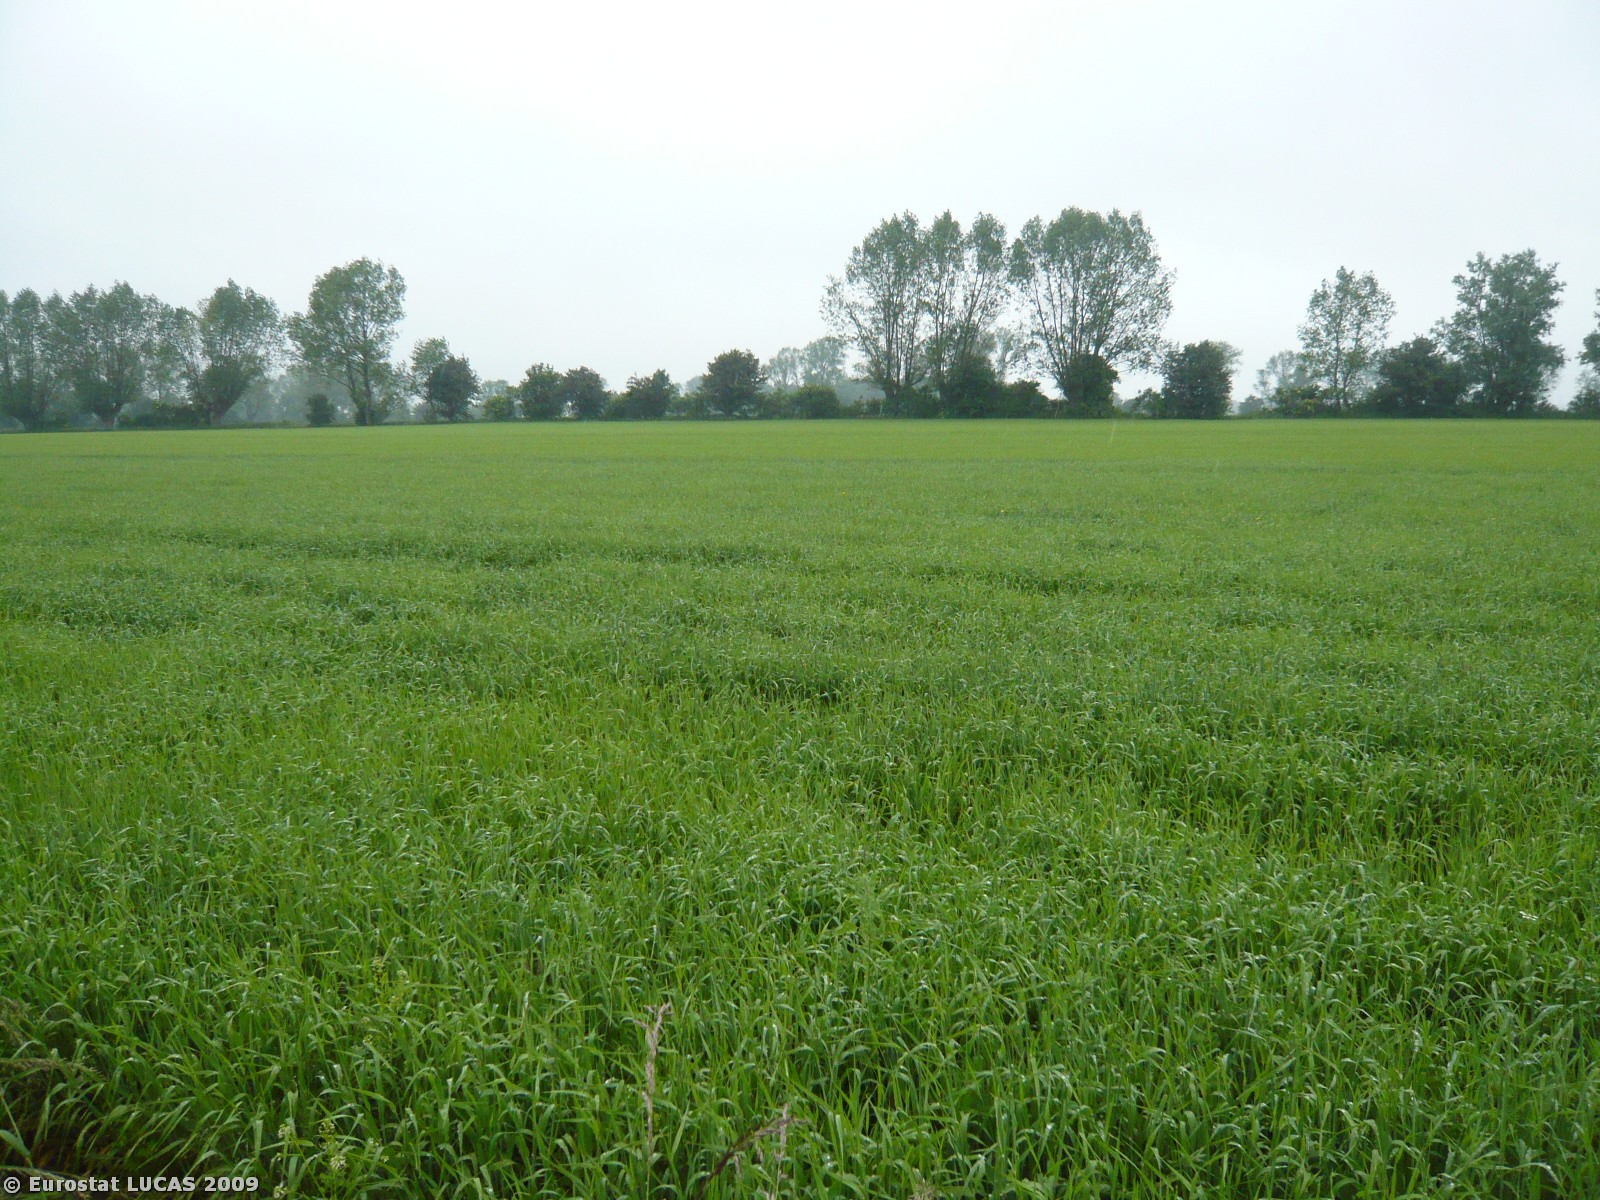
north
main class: Grassland
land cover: Grassland without tree/shrub cover
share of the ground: > 75 %
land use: Railway transport
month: June
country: DK
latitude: 54.7923
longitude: 11.6941
